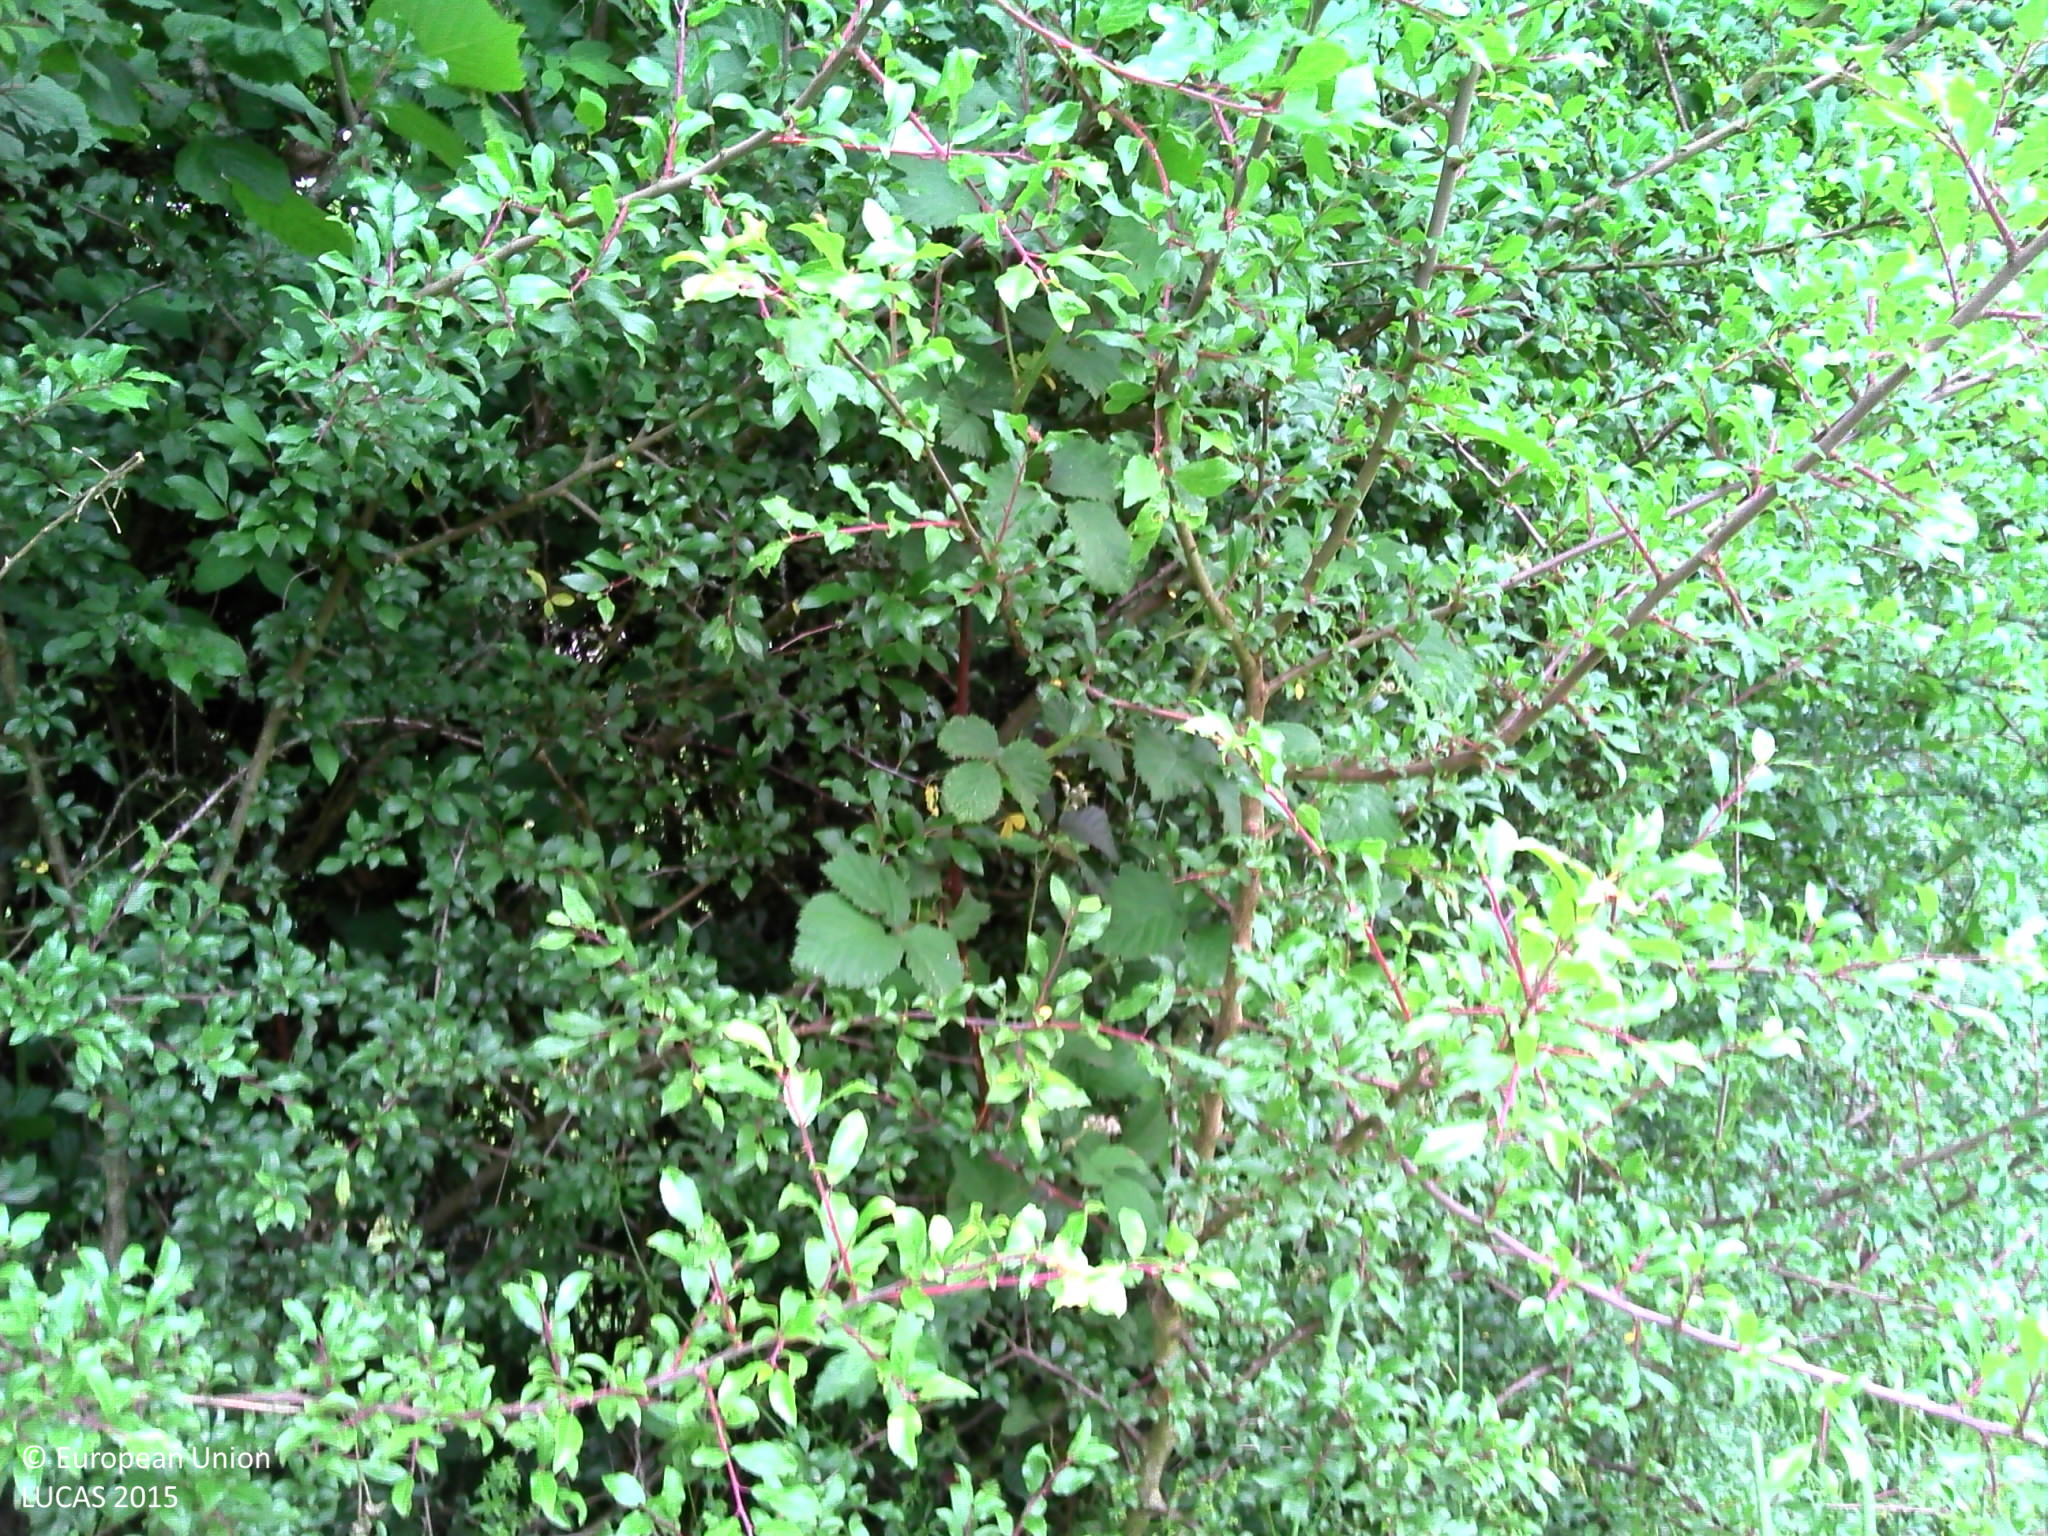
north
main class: Grassland
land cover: Grassland with sparse tree/shrub cover
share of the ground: > 75 %
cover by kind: herbaceous plants 95 %, broadleaved forest trees 5 %
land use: Agriculture (excluding fallow land and kitchen gardens)
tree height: > 5 m
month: June
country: BE
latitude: 50.2966
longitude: 5.5764
